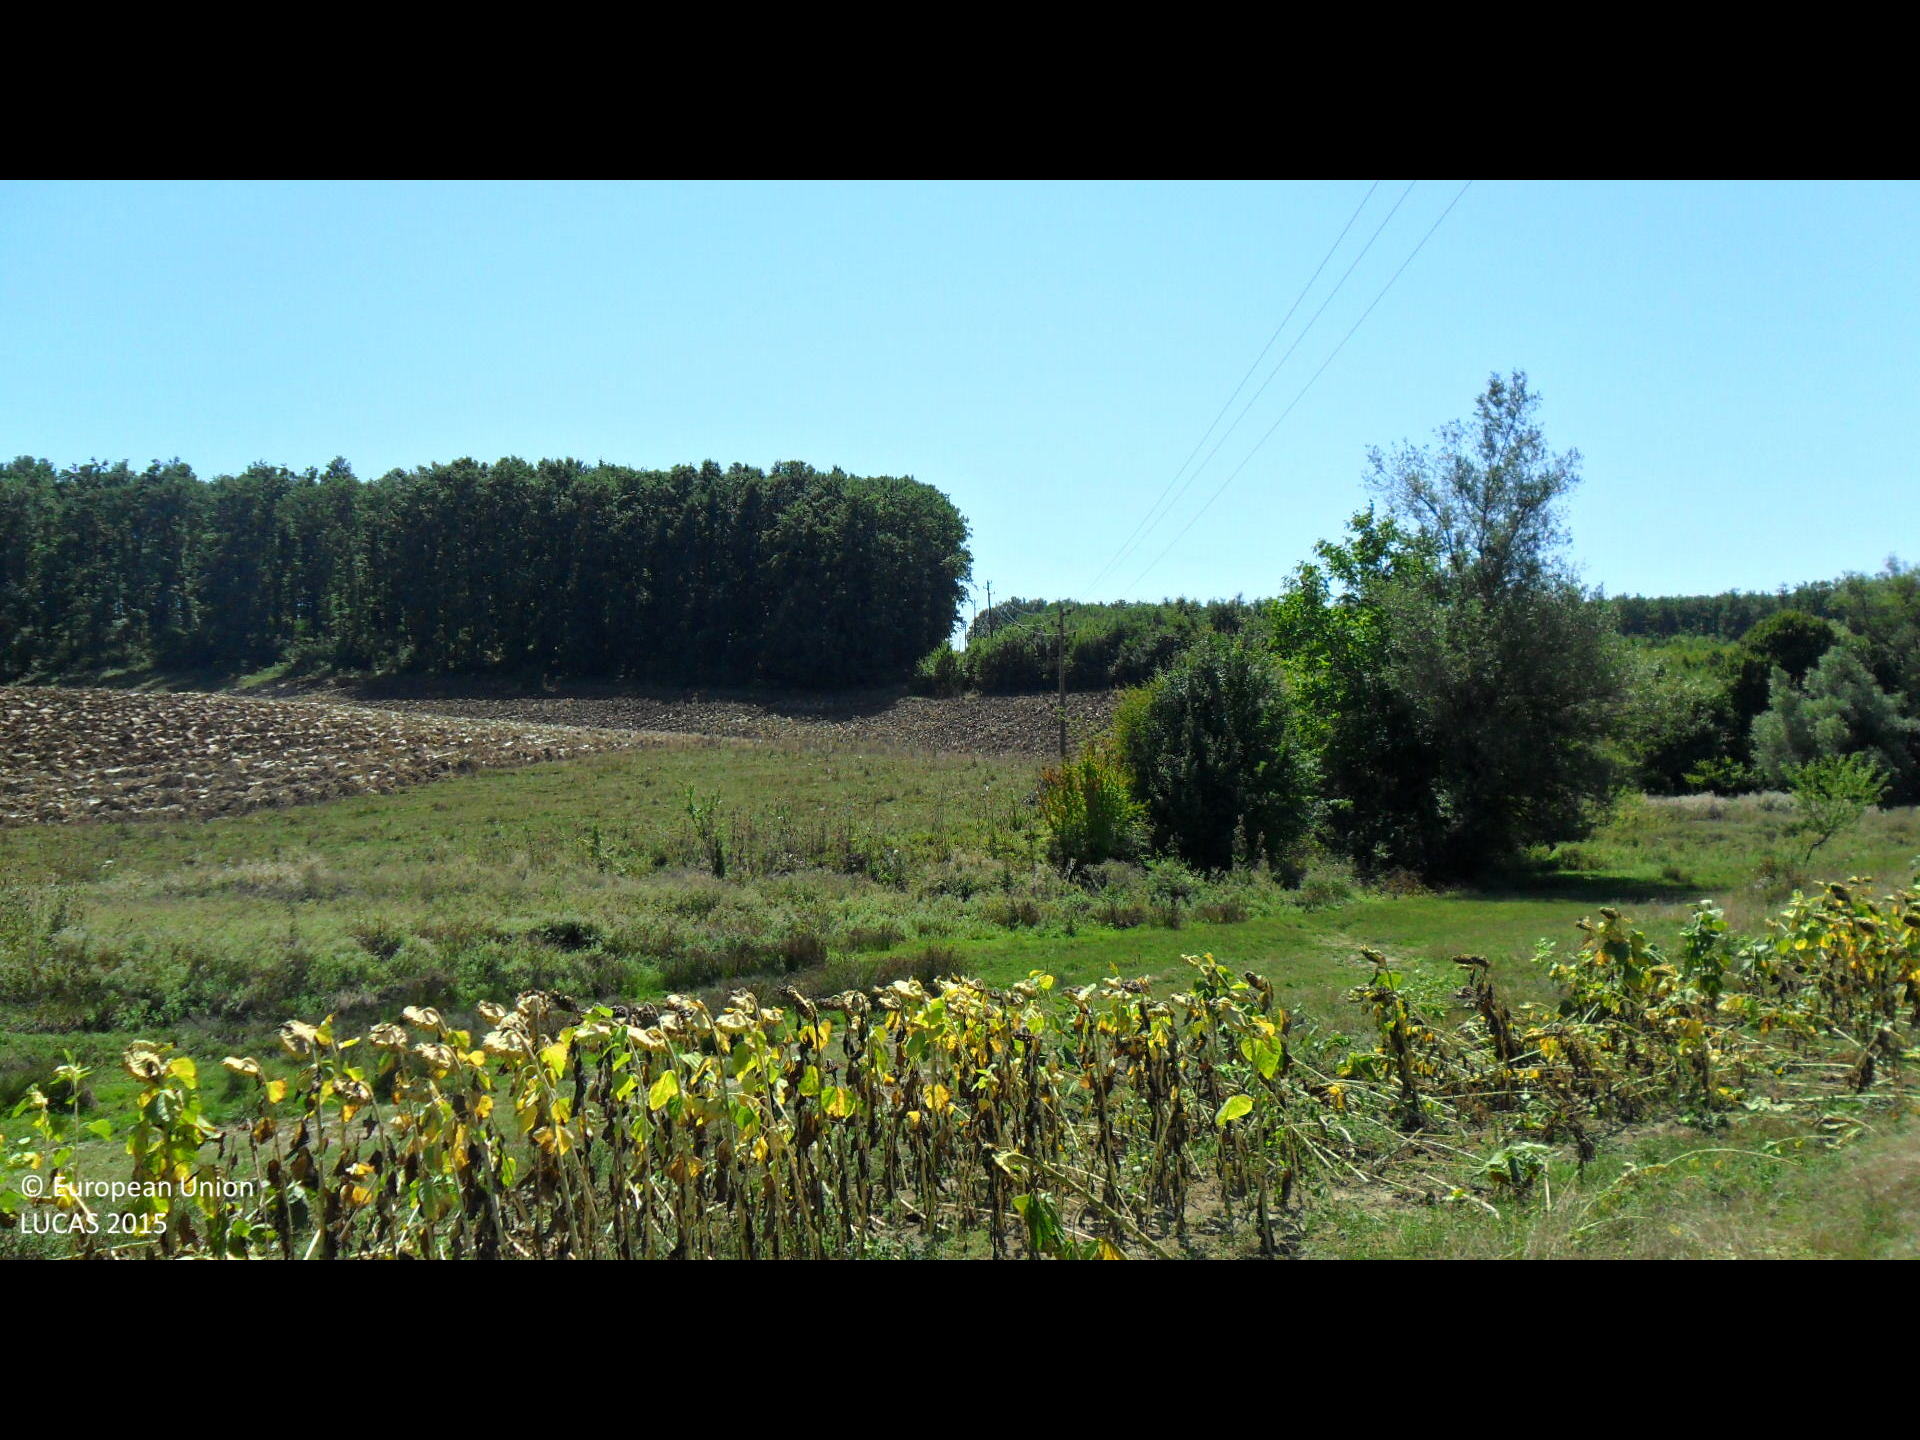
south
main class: Cropland
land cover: Sunflower
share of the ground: > 75 %
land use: Agriculture (excluding fallow land and kitchen gardens)
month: September
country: BG
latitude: 43.1820
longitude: 26.4000
